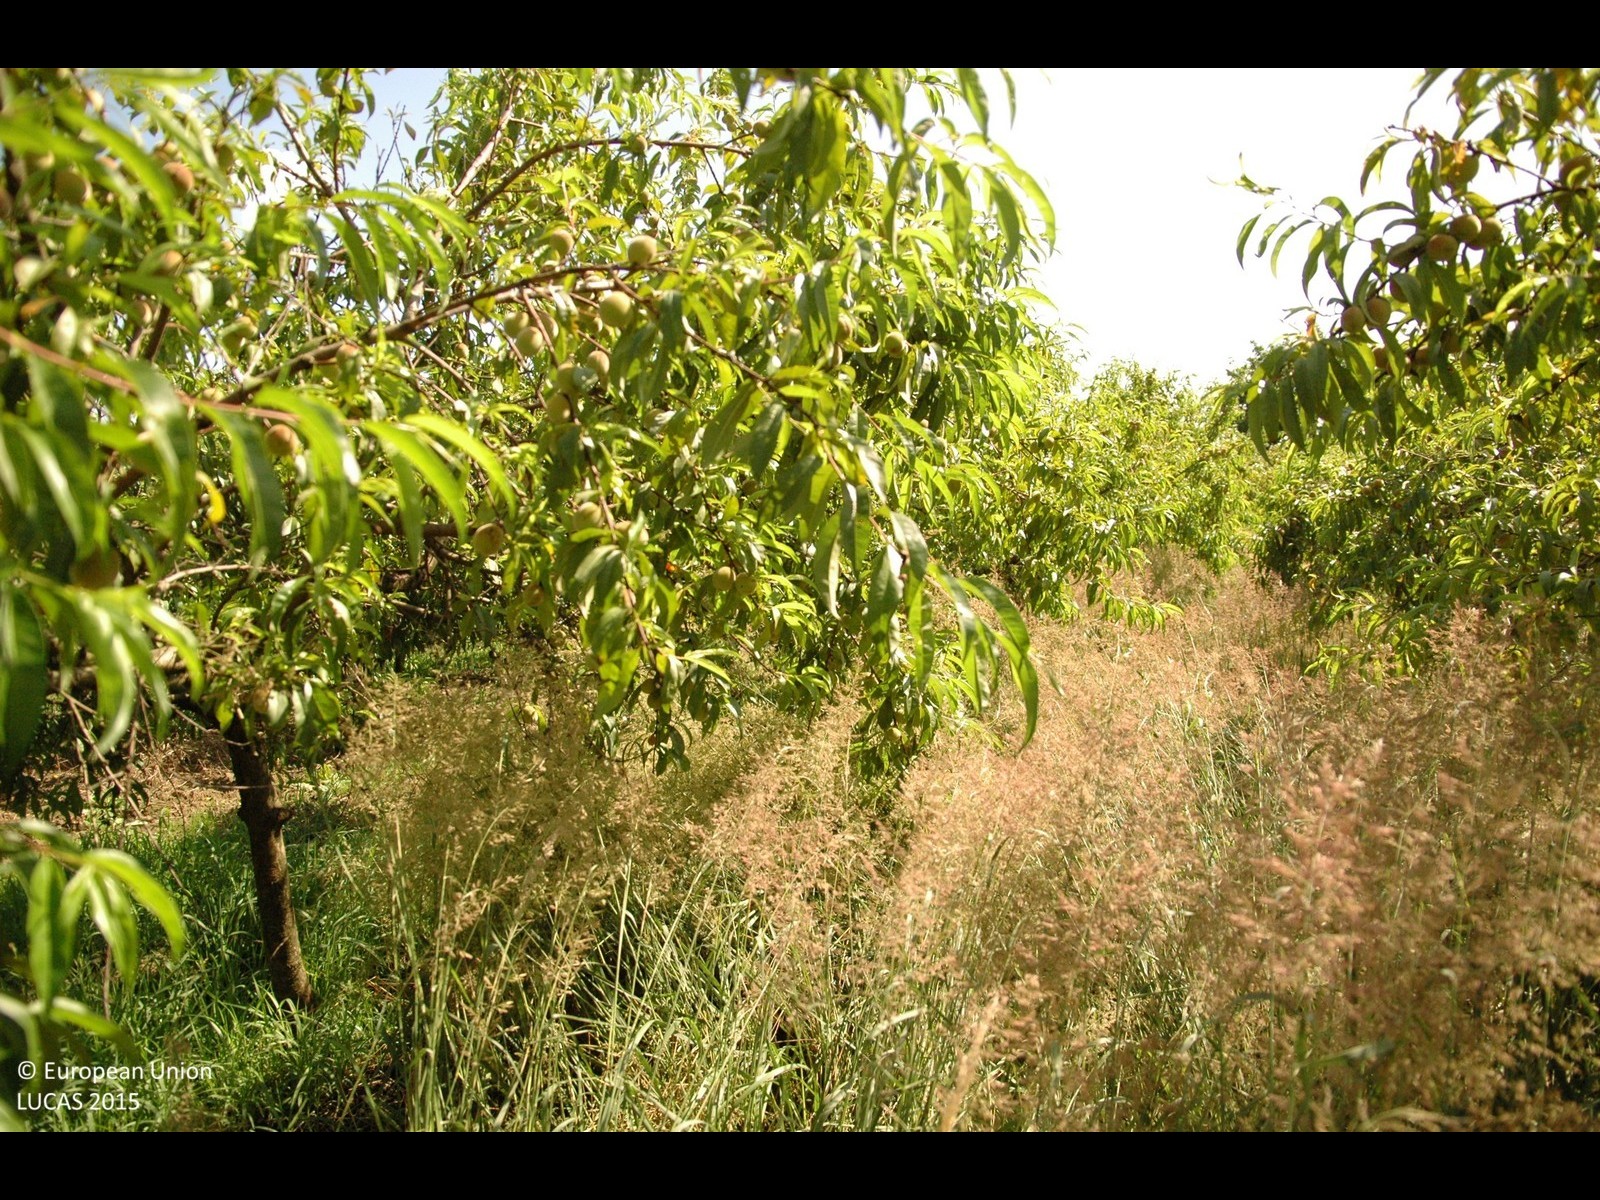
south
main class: Cropland
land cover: Other fruit trees and berries
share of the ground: > 75 %
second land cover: Grassland without tree/shrub cover
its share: 10 - 25 %
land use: Agriculture (excluding fallow land and kitchen gardens)
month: June
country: HR
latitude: 46.4364
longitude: 16.5999
